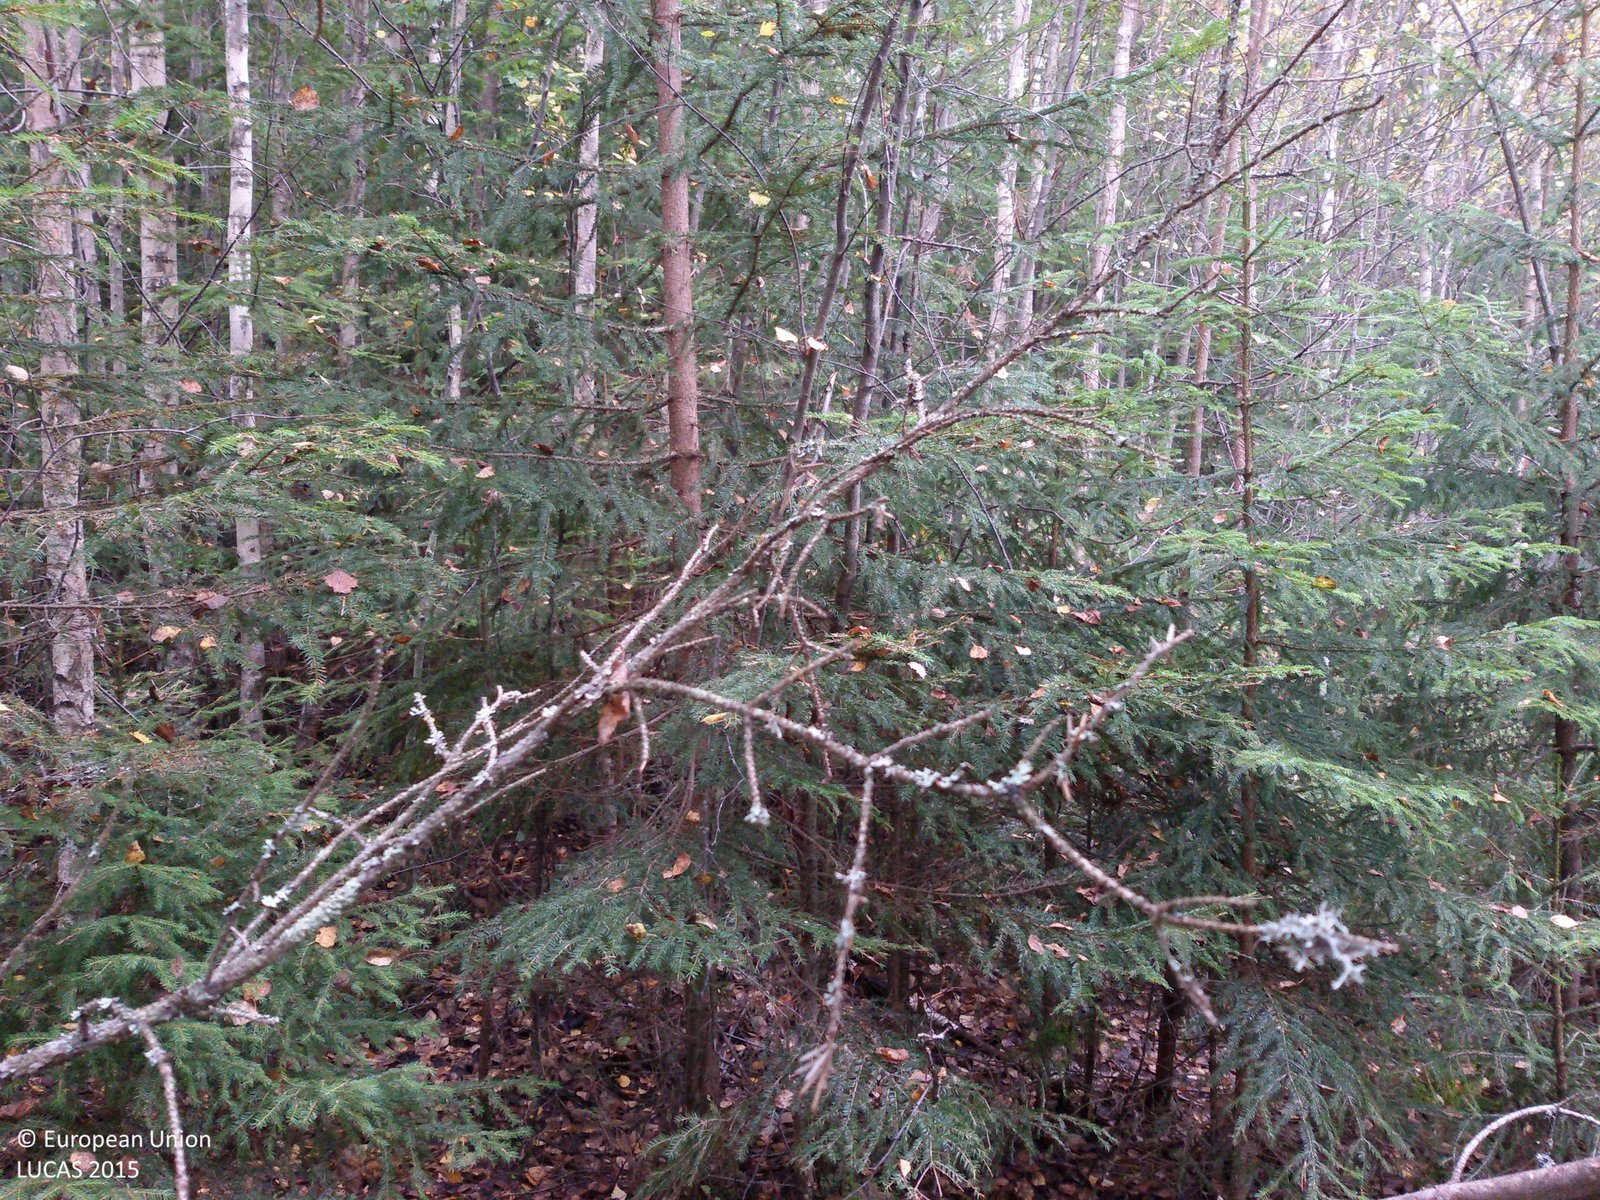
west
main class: Woodland
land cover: Spruce dominated mixed woodland
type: boreal forest
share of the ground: > 75 %
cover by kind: coniferous forest trees 50 %, broadleaved forest trees 50 %
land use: Forestry
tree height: > 5 m
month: September
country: SE
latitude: 60.7469
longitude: 14.8485
